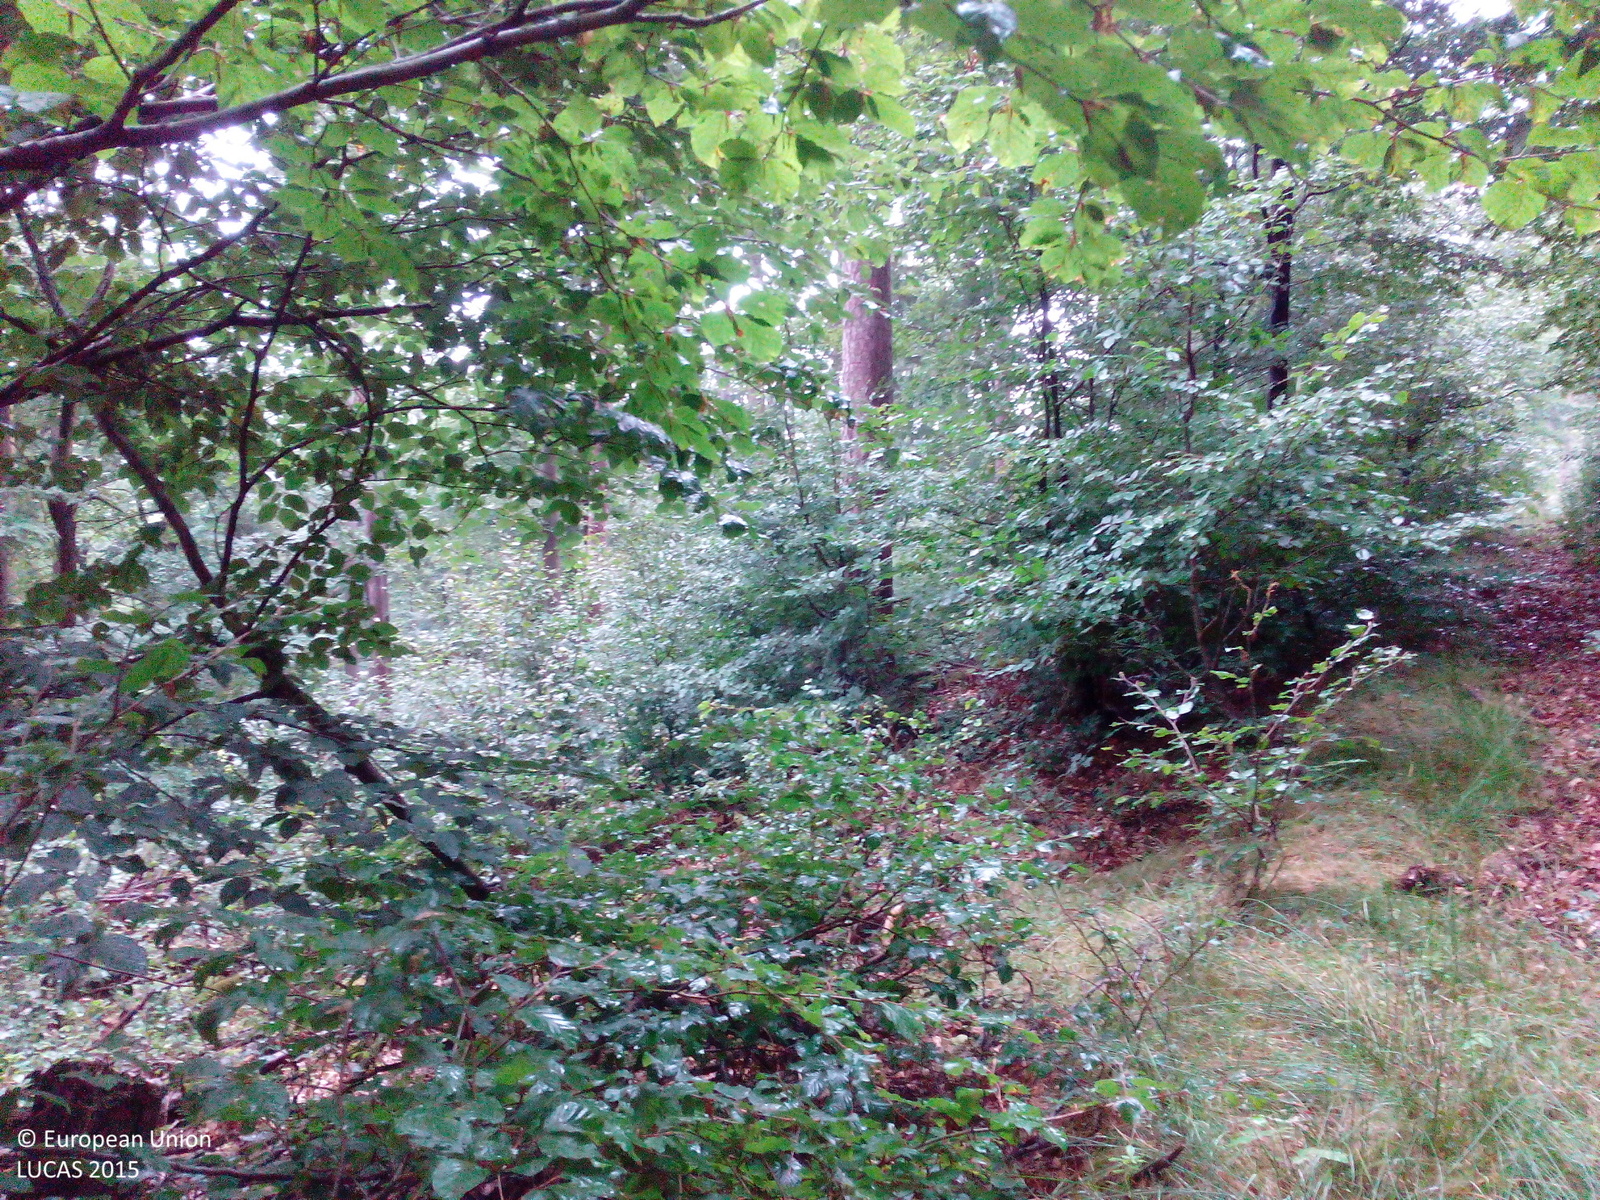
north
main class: Woodland
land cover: Pine dominated mixed woodland
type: hemiboreal forest and nemoral coniferous forest and mixed broadleaved-coniferous forest
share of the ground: > 75 %
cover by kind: broadleaved forest trees 65 %, coniferous forest trees 25 %, herbaceous plants 5 %, unconsolidated bare surface 5 %
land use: Forestry
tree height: > 5 m
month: September
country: DE
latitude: 49.9309
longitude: 9.4012
